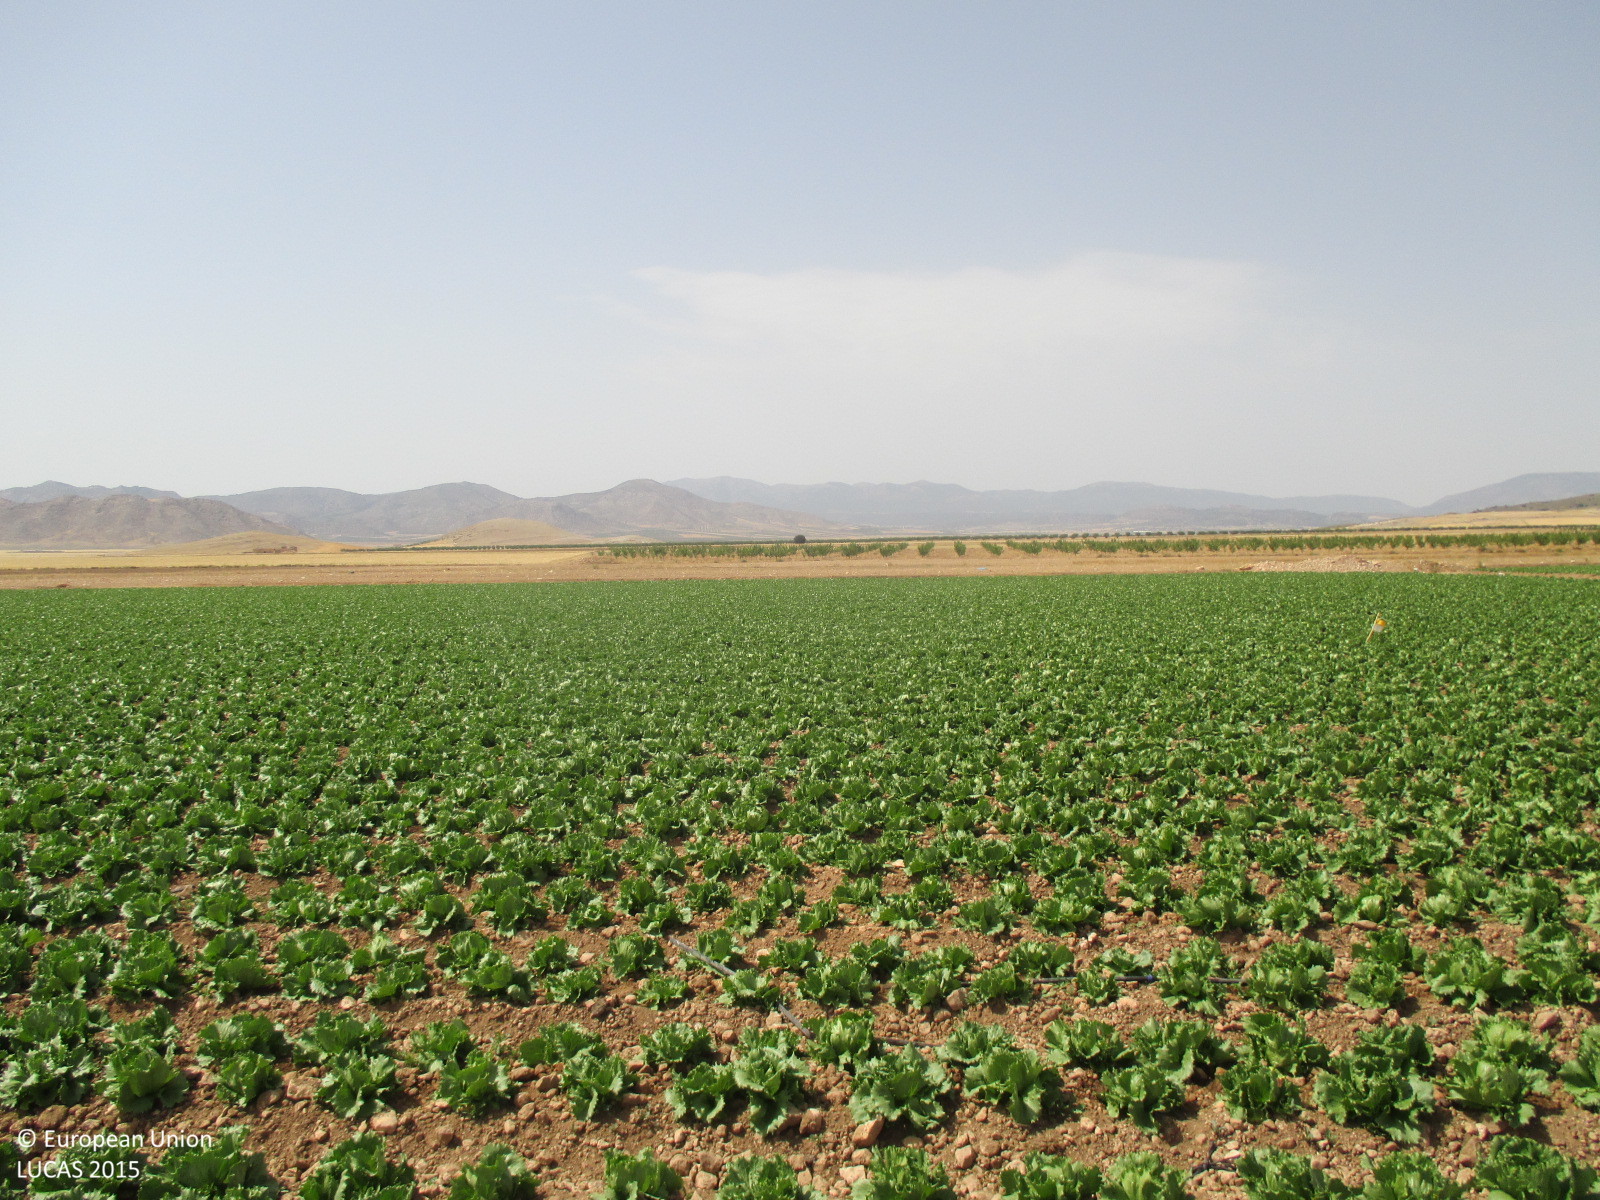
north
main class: Cropland
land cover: Other fresh vegetables
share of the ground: < 10 %
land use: Agriculture (excluding fallow land and kitchen gardens)
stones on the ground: 10 - 25 %
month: July
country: ES
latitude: 37.8977
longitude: -2.3055
